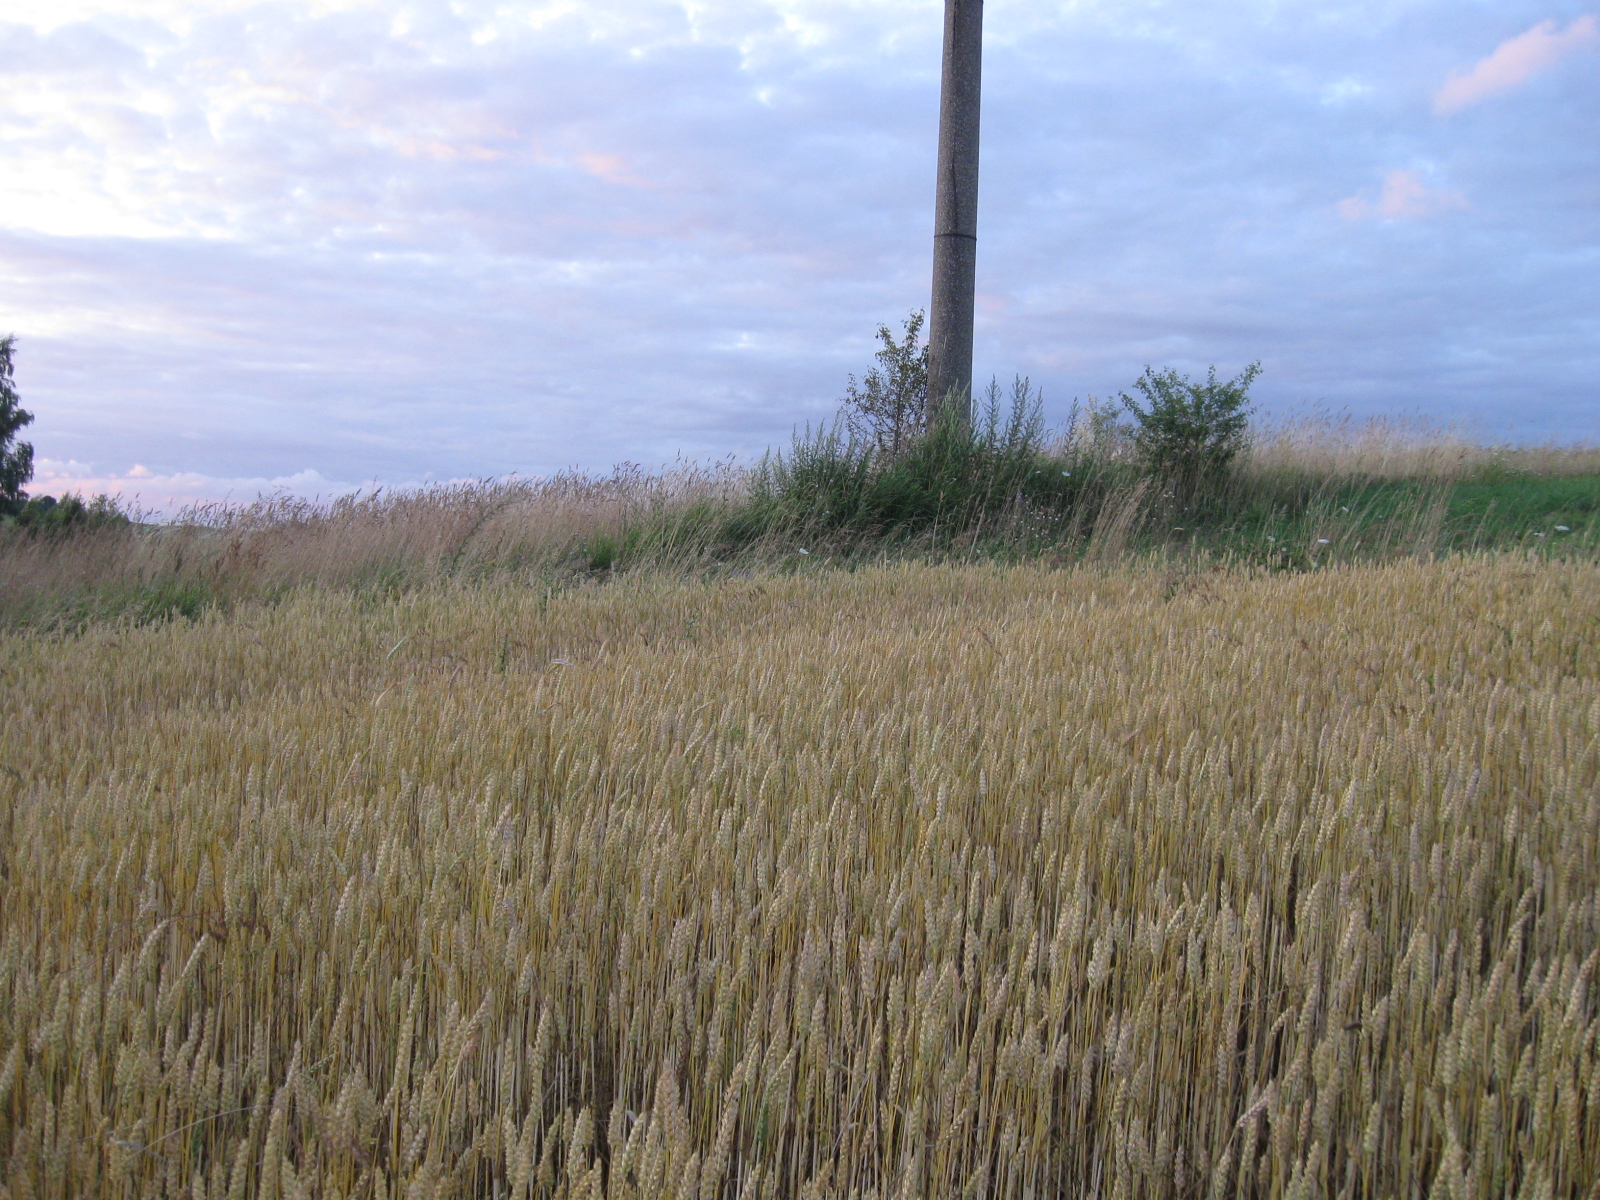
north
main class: Cropland
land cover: Common wheat
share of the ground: > 75 %
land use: Agriculture (excluding fallow land and kitchen gardens)
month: July
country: LT
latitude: 54.3707
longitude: 24.3380
